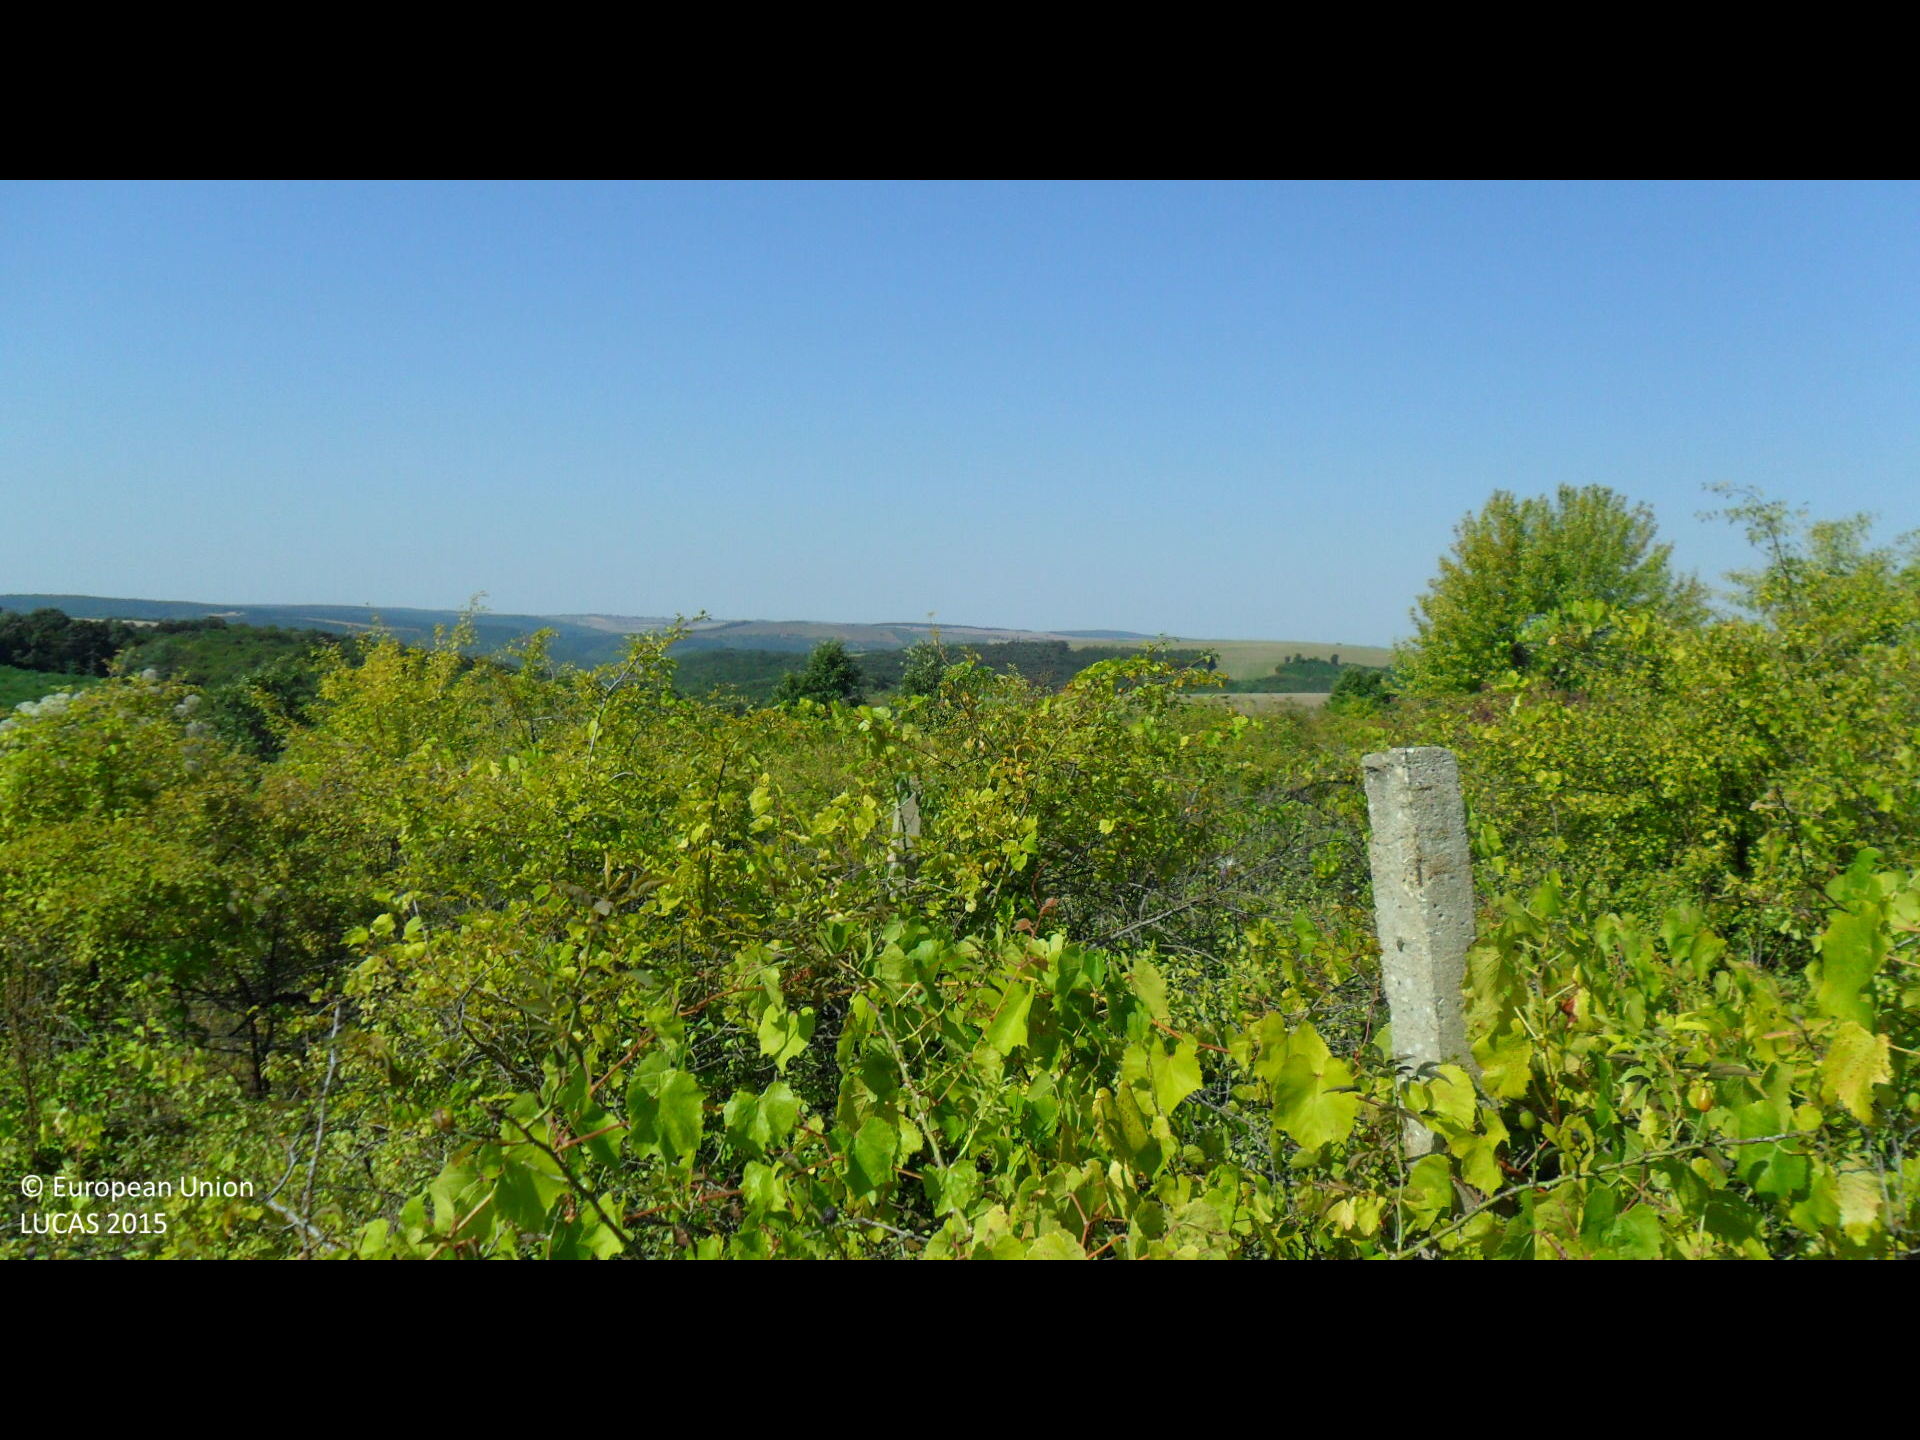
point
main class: Cropland
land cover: Vineyards
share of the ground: 50 - 75 %
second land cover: Shrubland without tree cover
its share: 50 - 75 %
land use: Abandoned areas
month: August
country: BG
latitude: 43.4922
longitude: 26.1850
